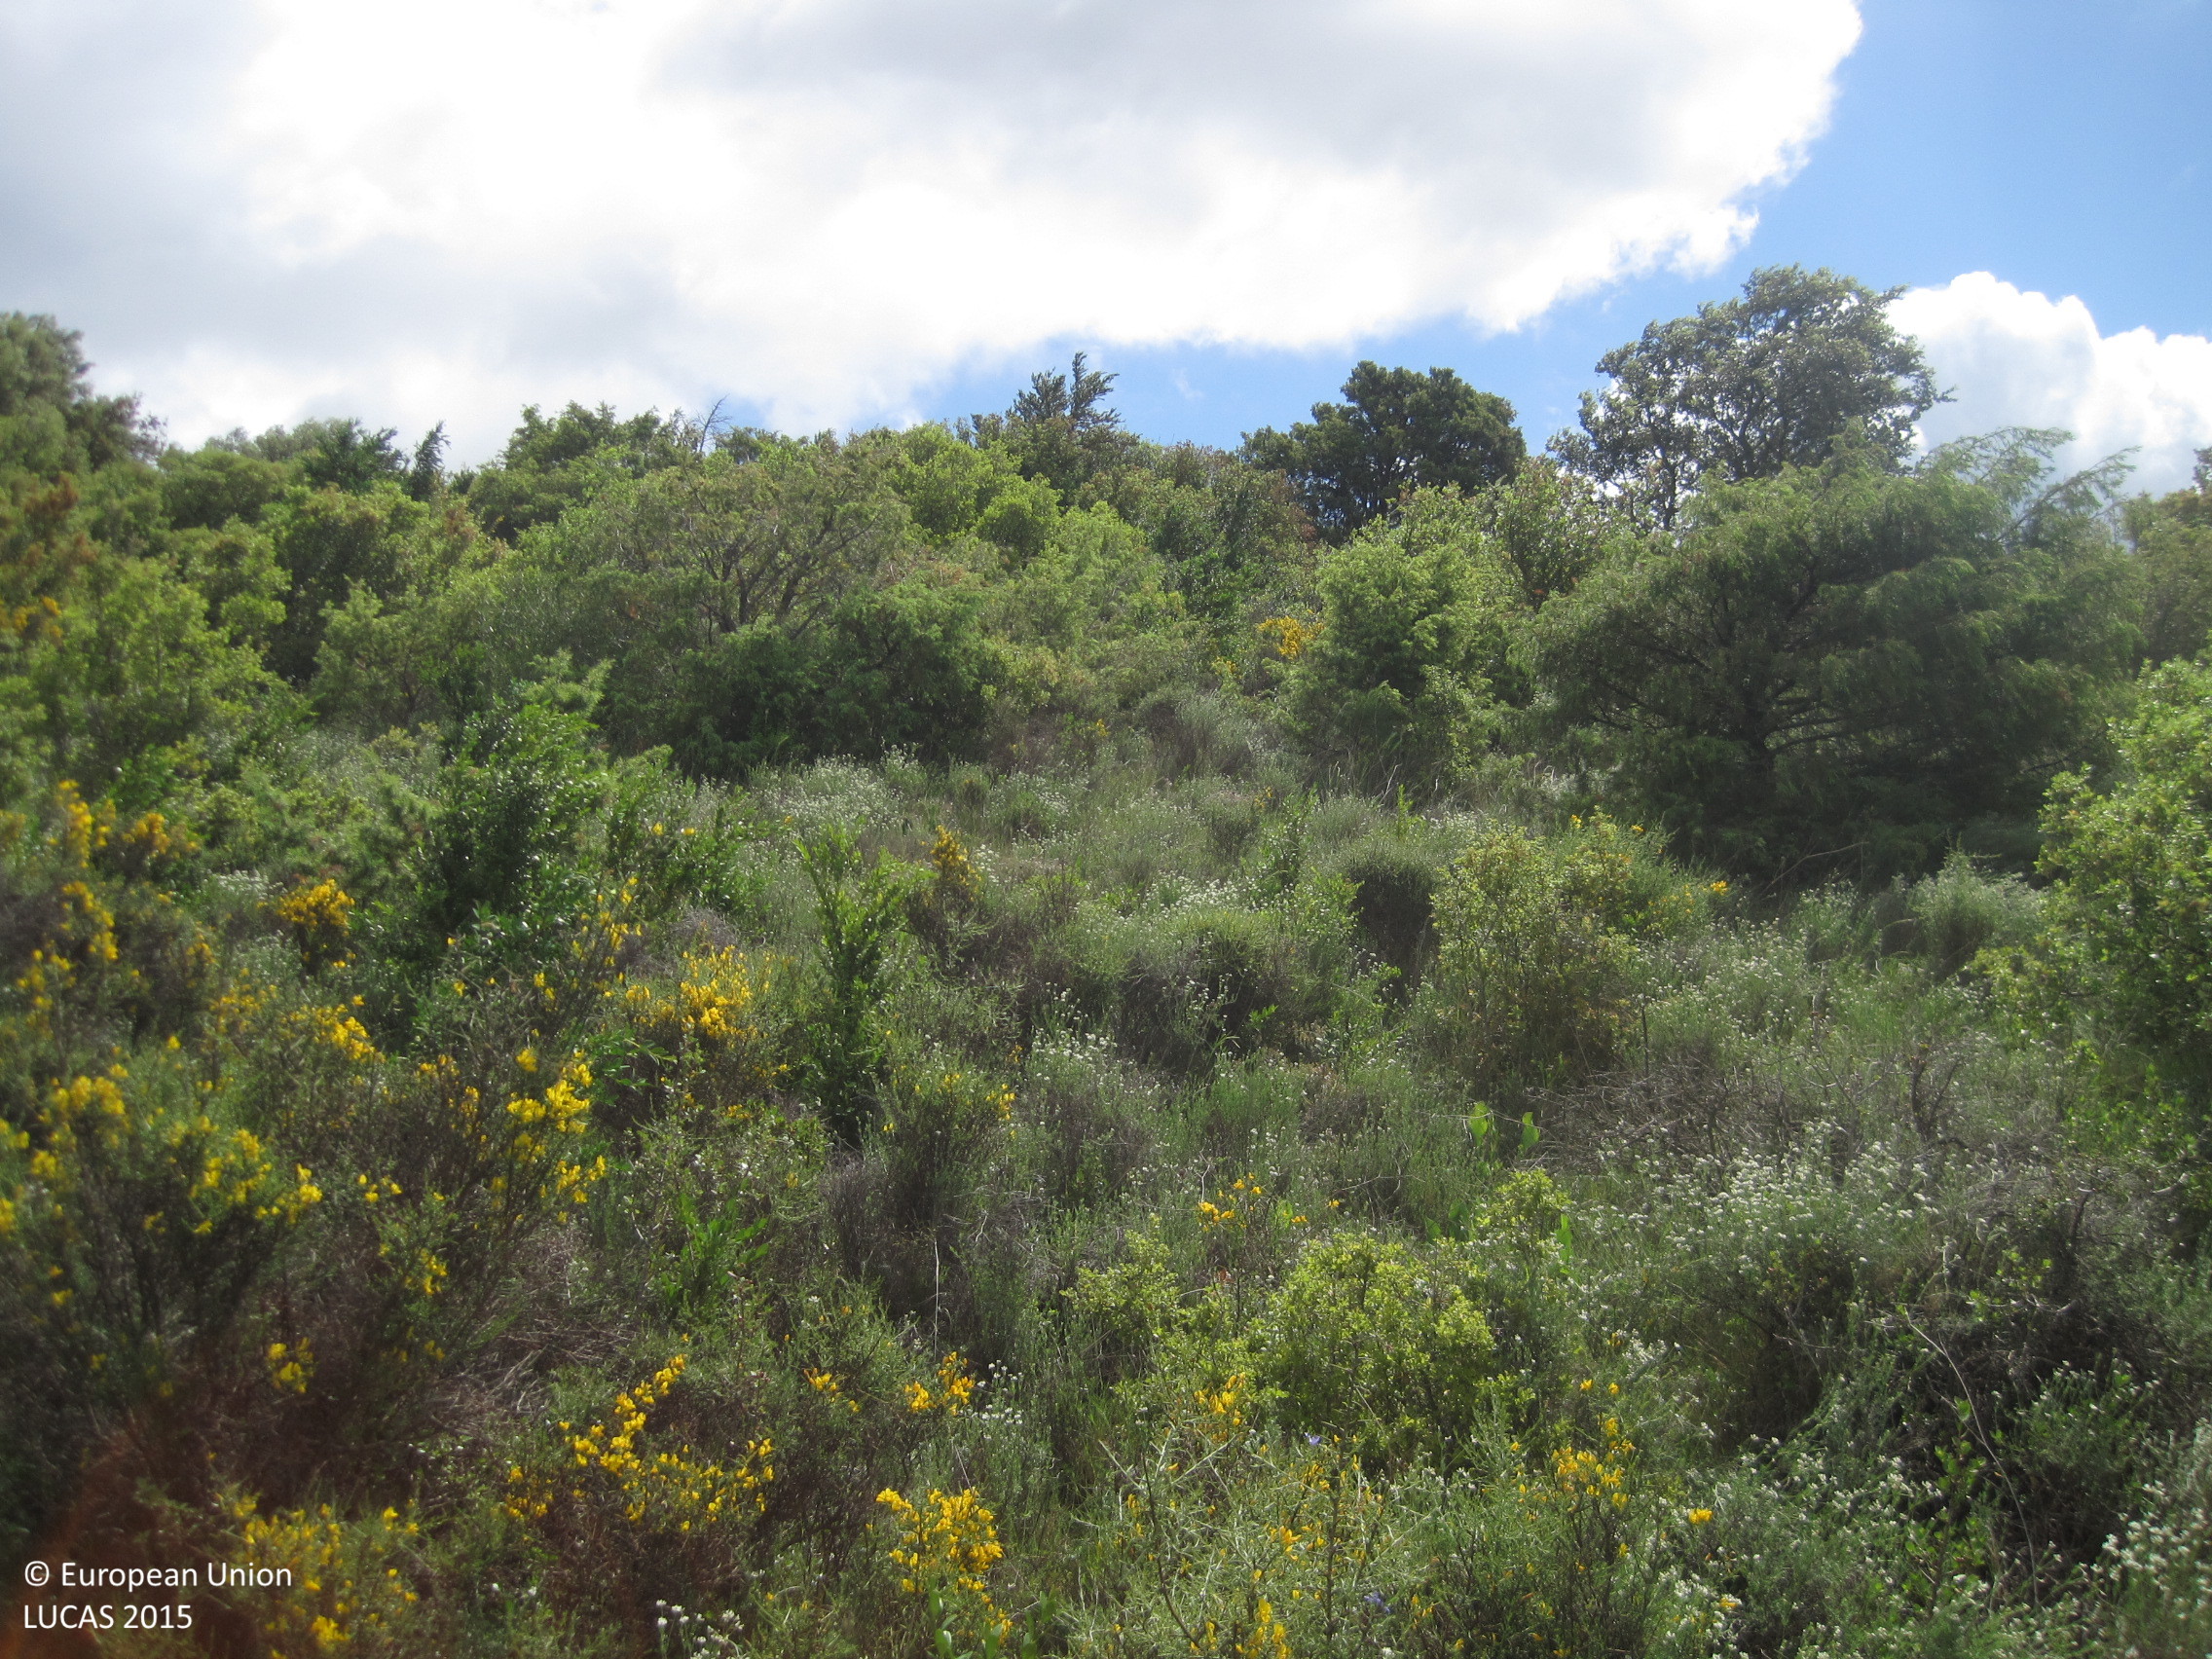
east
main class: Shrubland
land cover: Shrubland with sparse tree cover
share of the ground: > 75 %
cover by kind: shrubs 90 %, broadleaved forest trees 5 %, herbaceous plants 5 %
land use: Semi-natural and natural areas not in use
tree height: > 5 m
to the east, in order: Shrubland with sparse tree cover; Tracks; Pine dominated mixed woodland; Common wheat; Pine dominated coniferous woodland
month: May
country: ES
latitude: 42.6124
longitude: -1.2117
